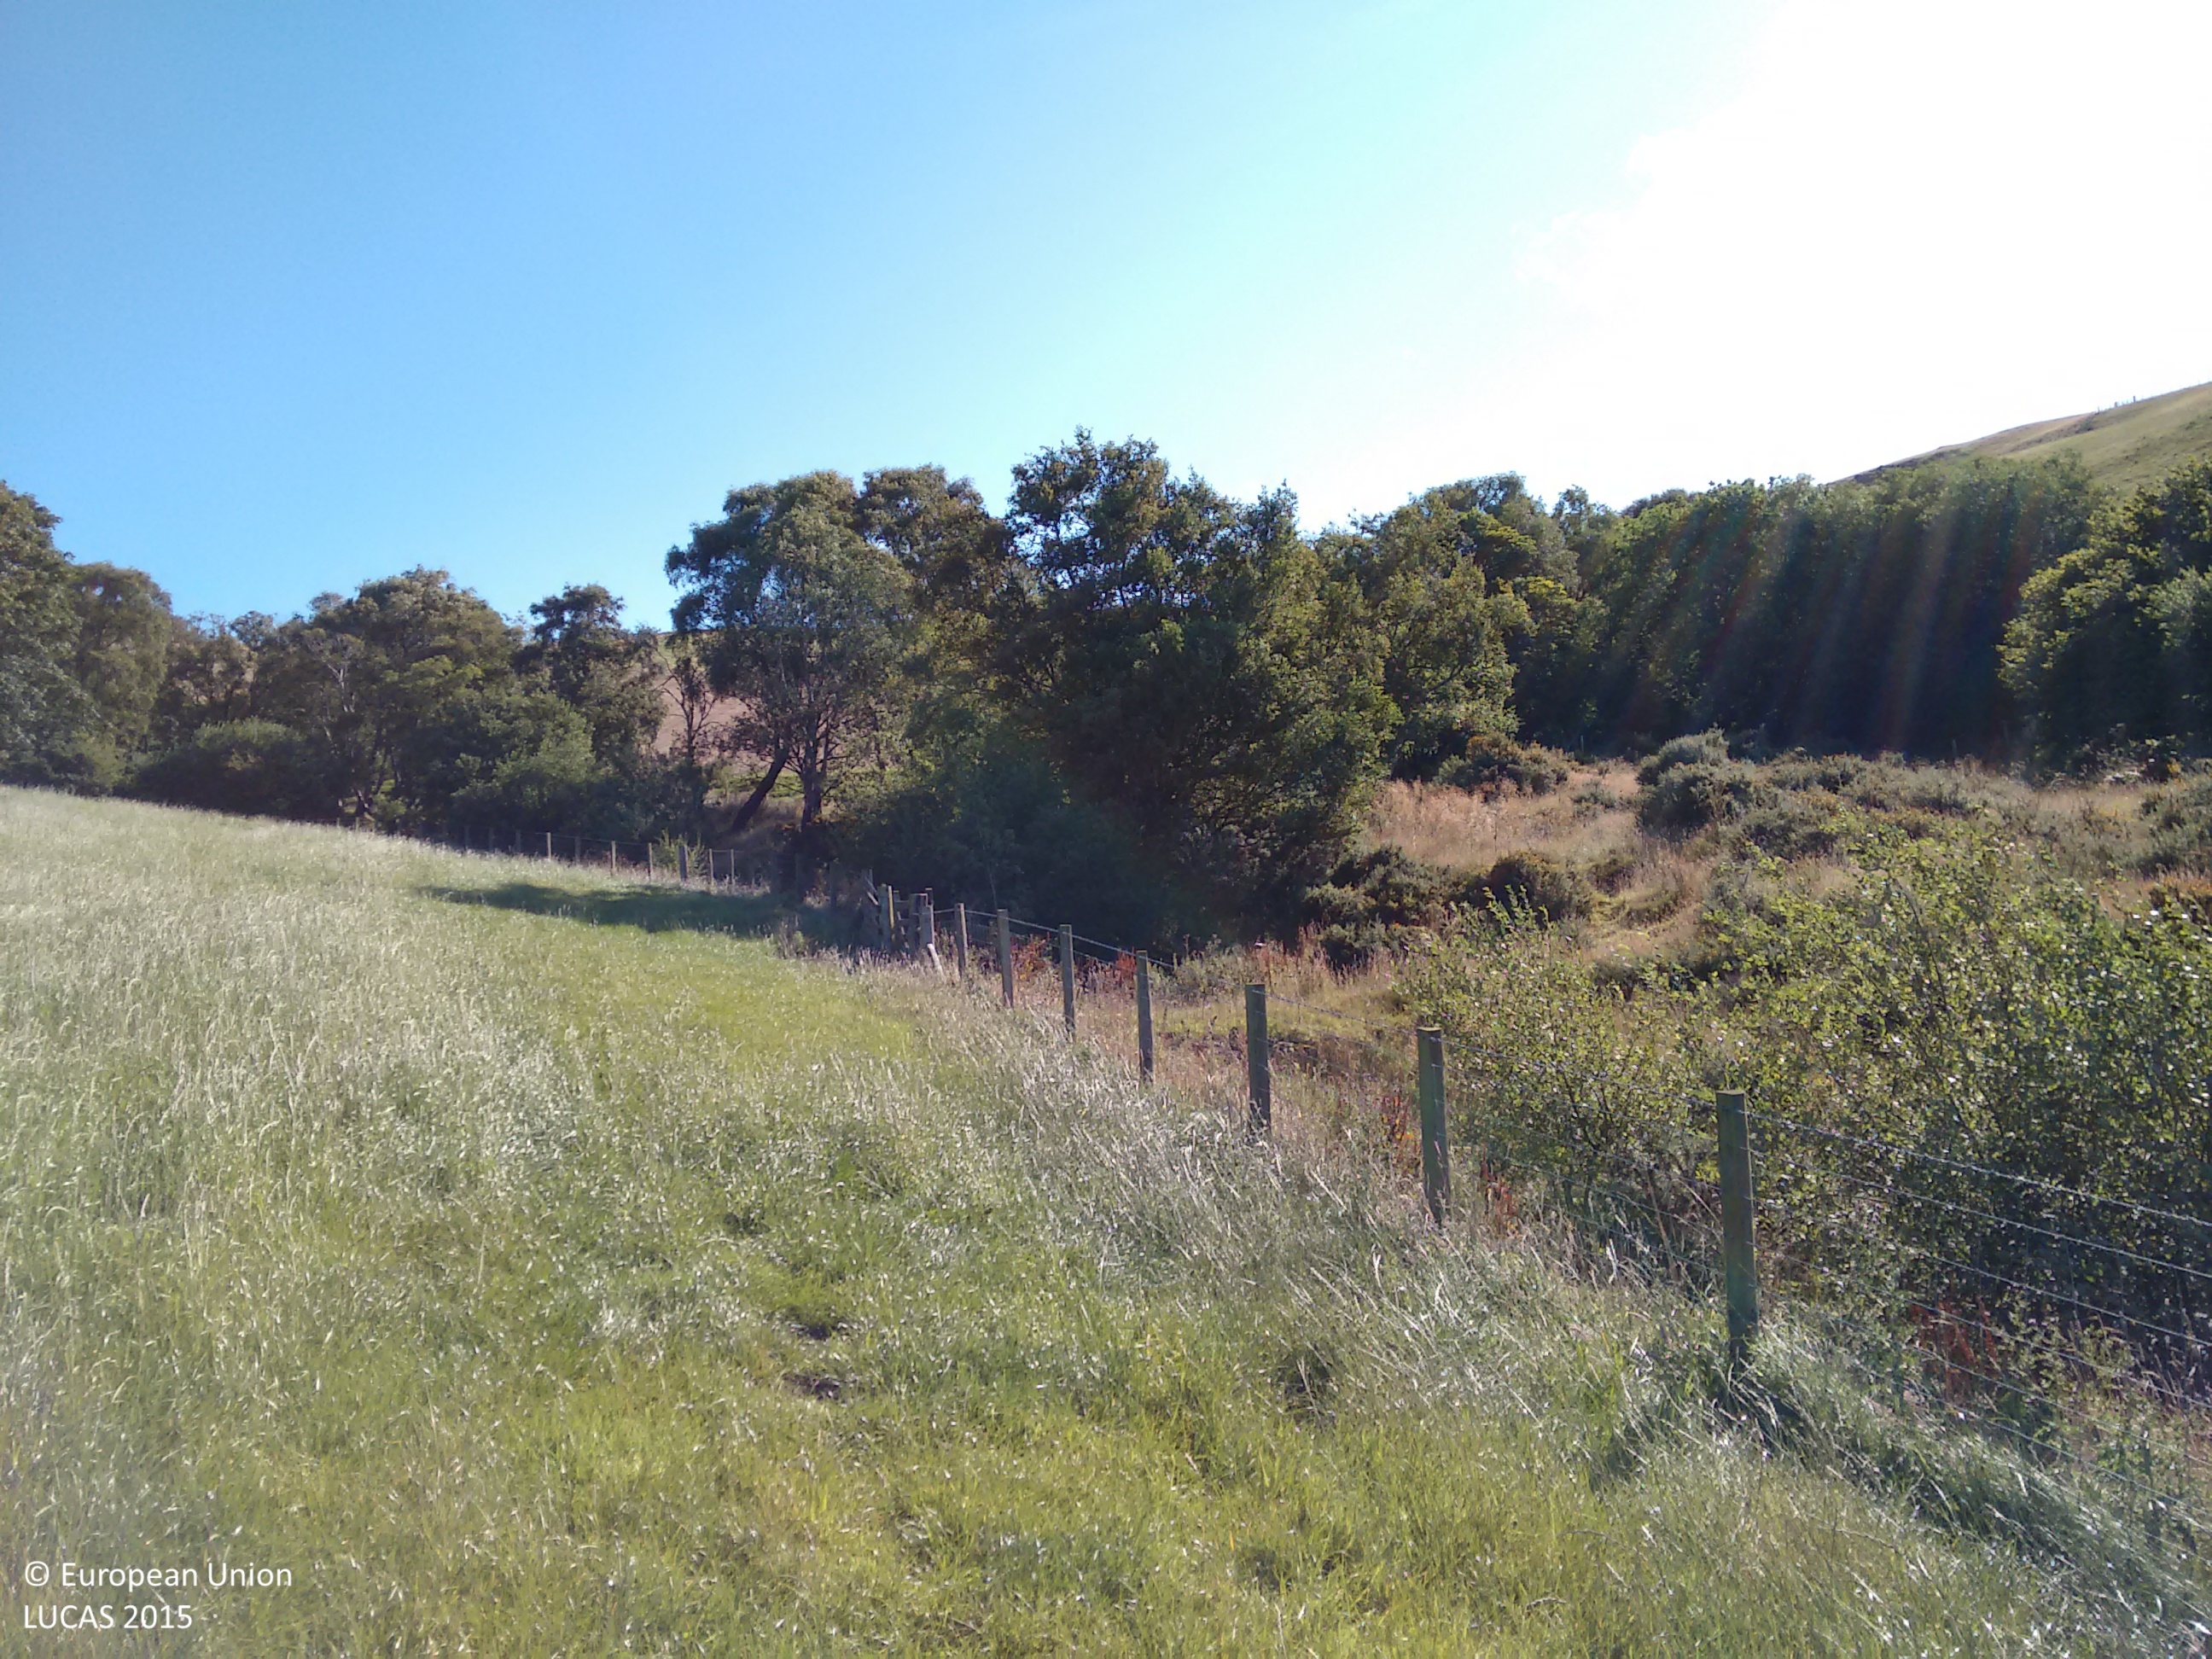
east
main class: Grassland
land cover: Grassland without tree/shrub cover
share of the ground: > 75 %
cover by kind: herbaceous plants 100 %
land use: Agriculture (excluding fallow land and kitchen gardens)
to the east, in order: Grassland without tree/shrub cover; Fences; Grass margins; Rivers and streams; Single bushes/trees; Shrubland with sparse tree cover; Fences; Grassland with sparse tree/shrub cover; Inland fresh water bodies; Grass margins; Fences; Grassland without tree/shrub cover; Fences; Grassland with sparse tree/shrub cover
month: August
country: GB
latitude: 53.2020
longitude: -3.5433
